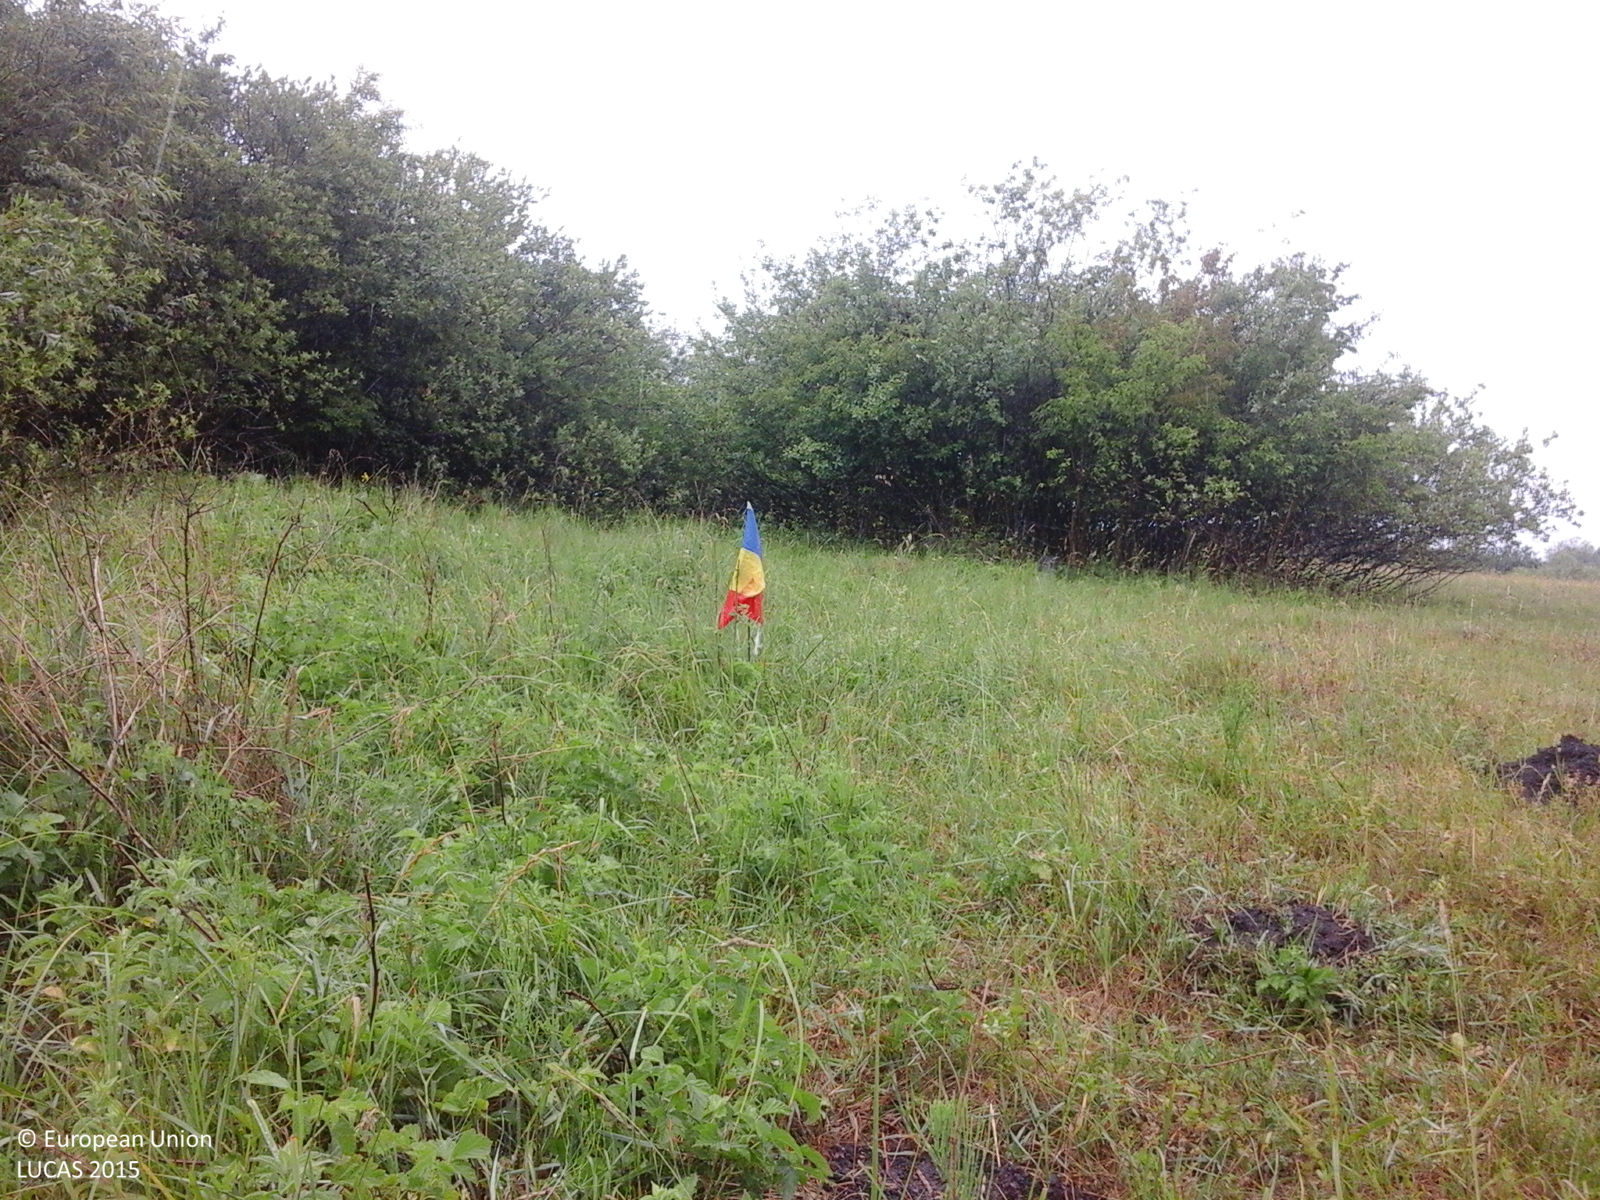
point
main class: Grassland
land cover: Grassland without tree/shrub cover
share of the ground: > 75 %
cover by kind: herbaceous plants 100 %
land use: Agriculture (excluding fallow land and kitchen gardens)
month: June
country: RO
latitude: 47.4361
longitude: 26.3262
